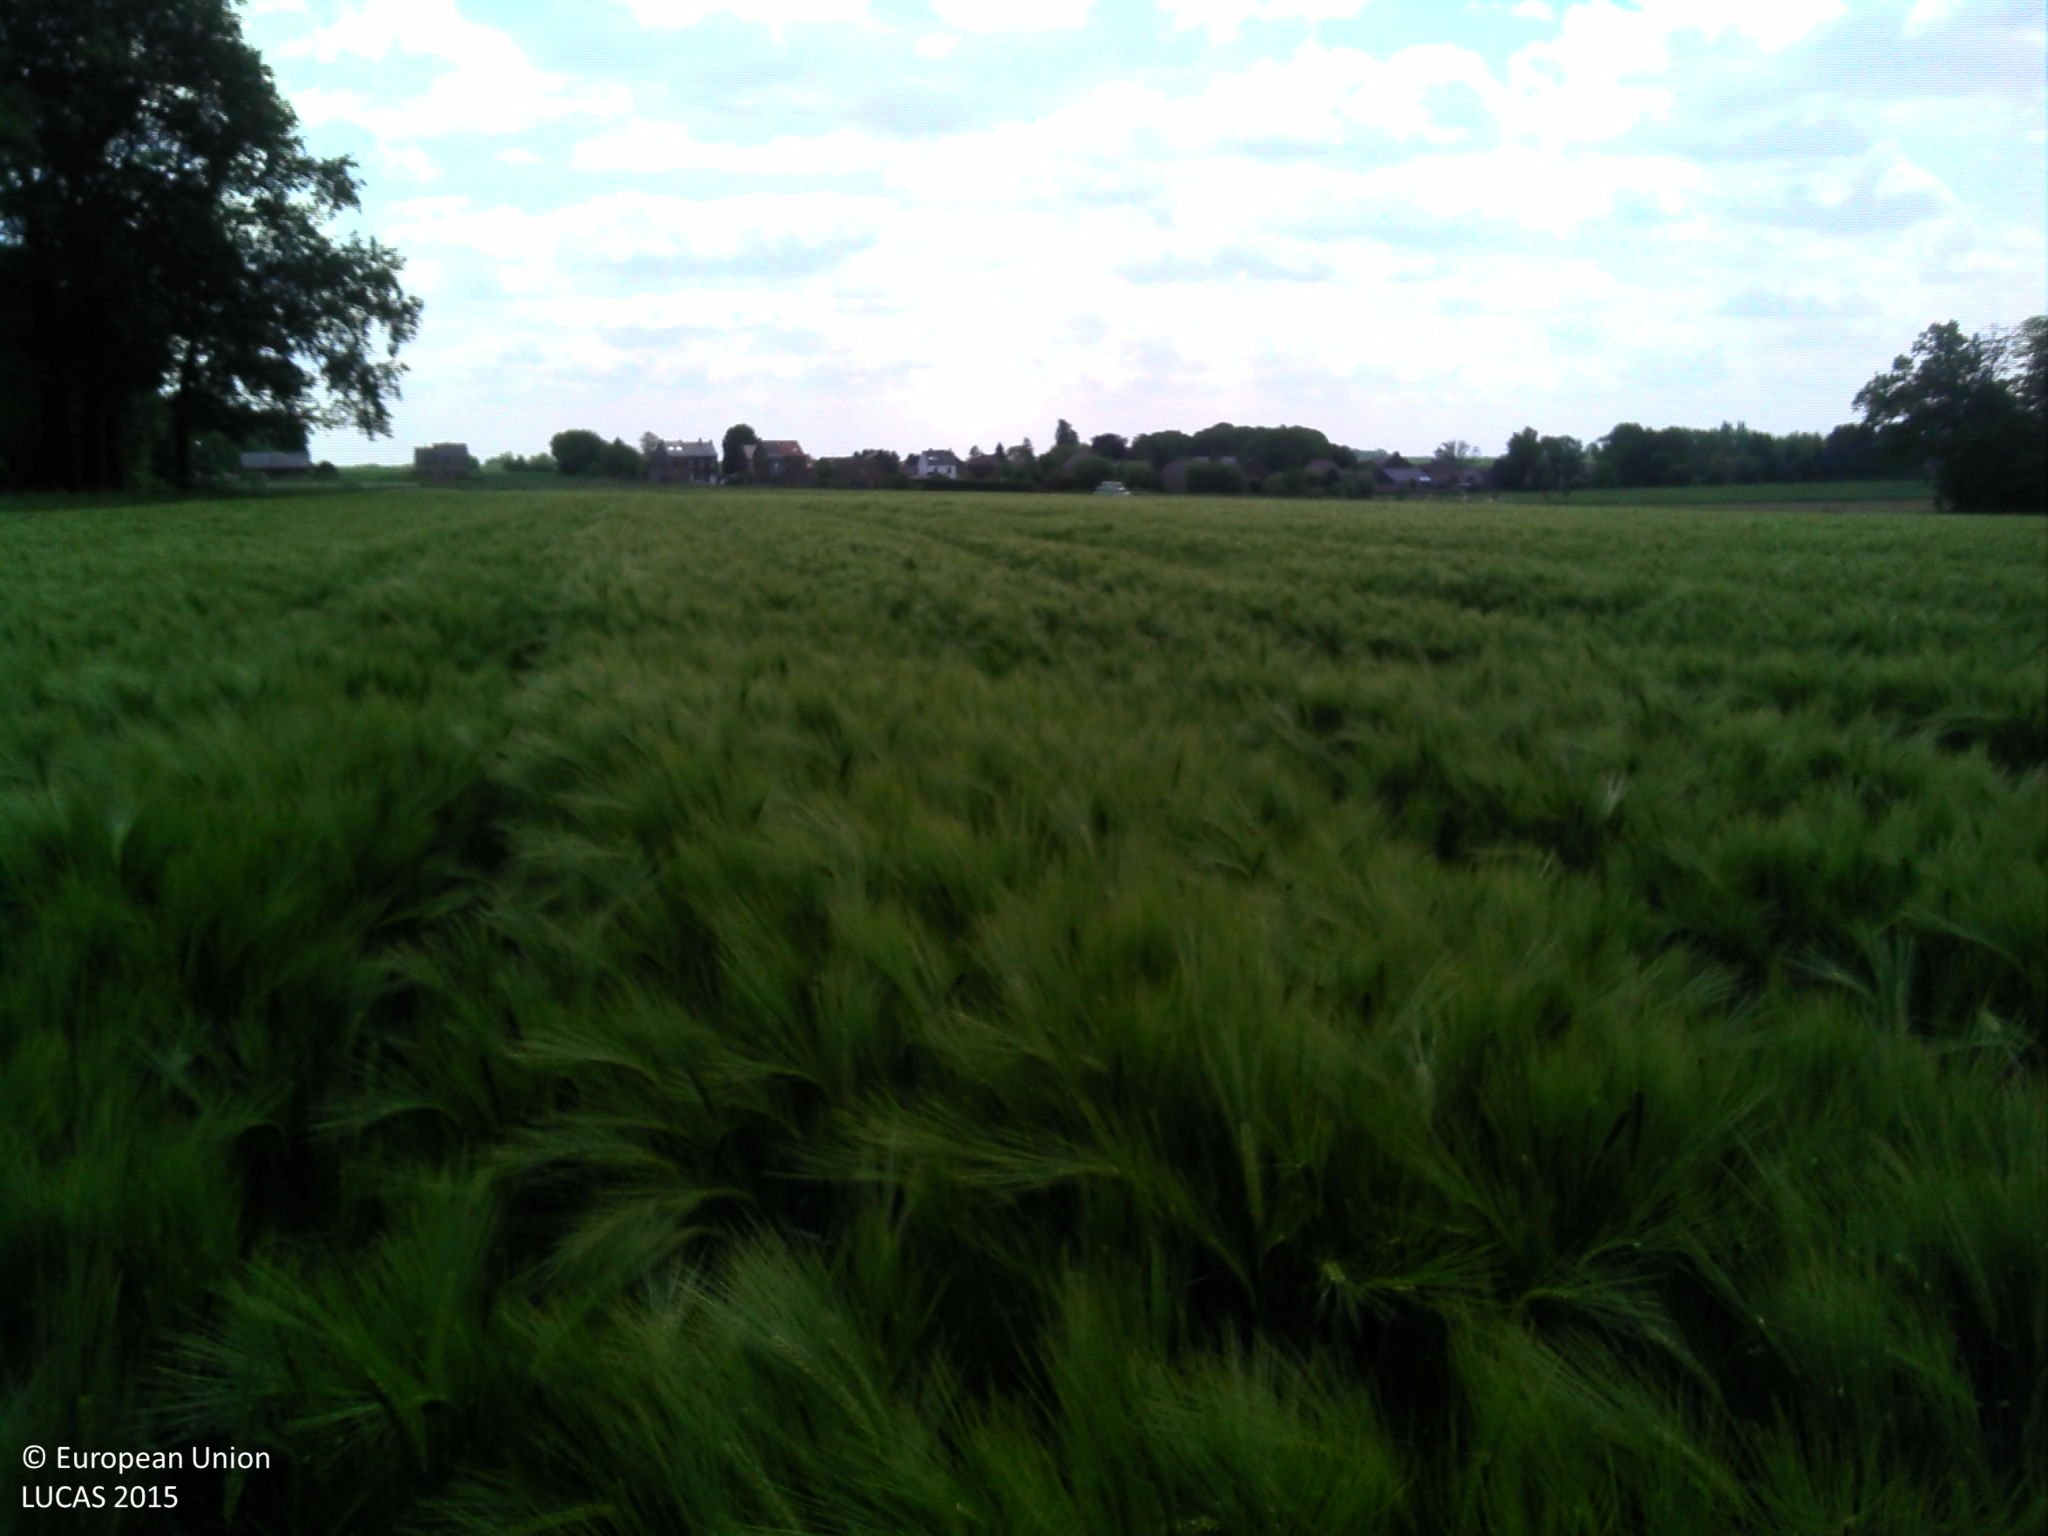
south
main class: Cropland
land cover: Barley
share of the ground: > 75 %
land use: Agriculture (excluding fallow land and kitchen gardens)
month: May
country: BE
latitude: 50.5372
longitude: 4.4790
